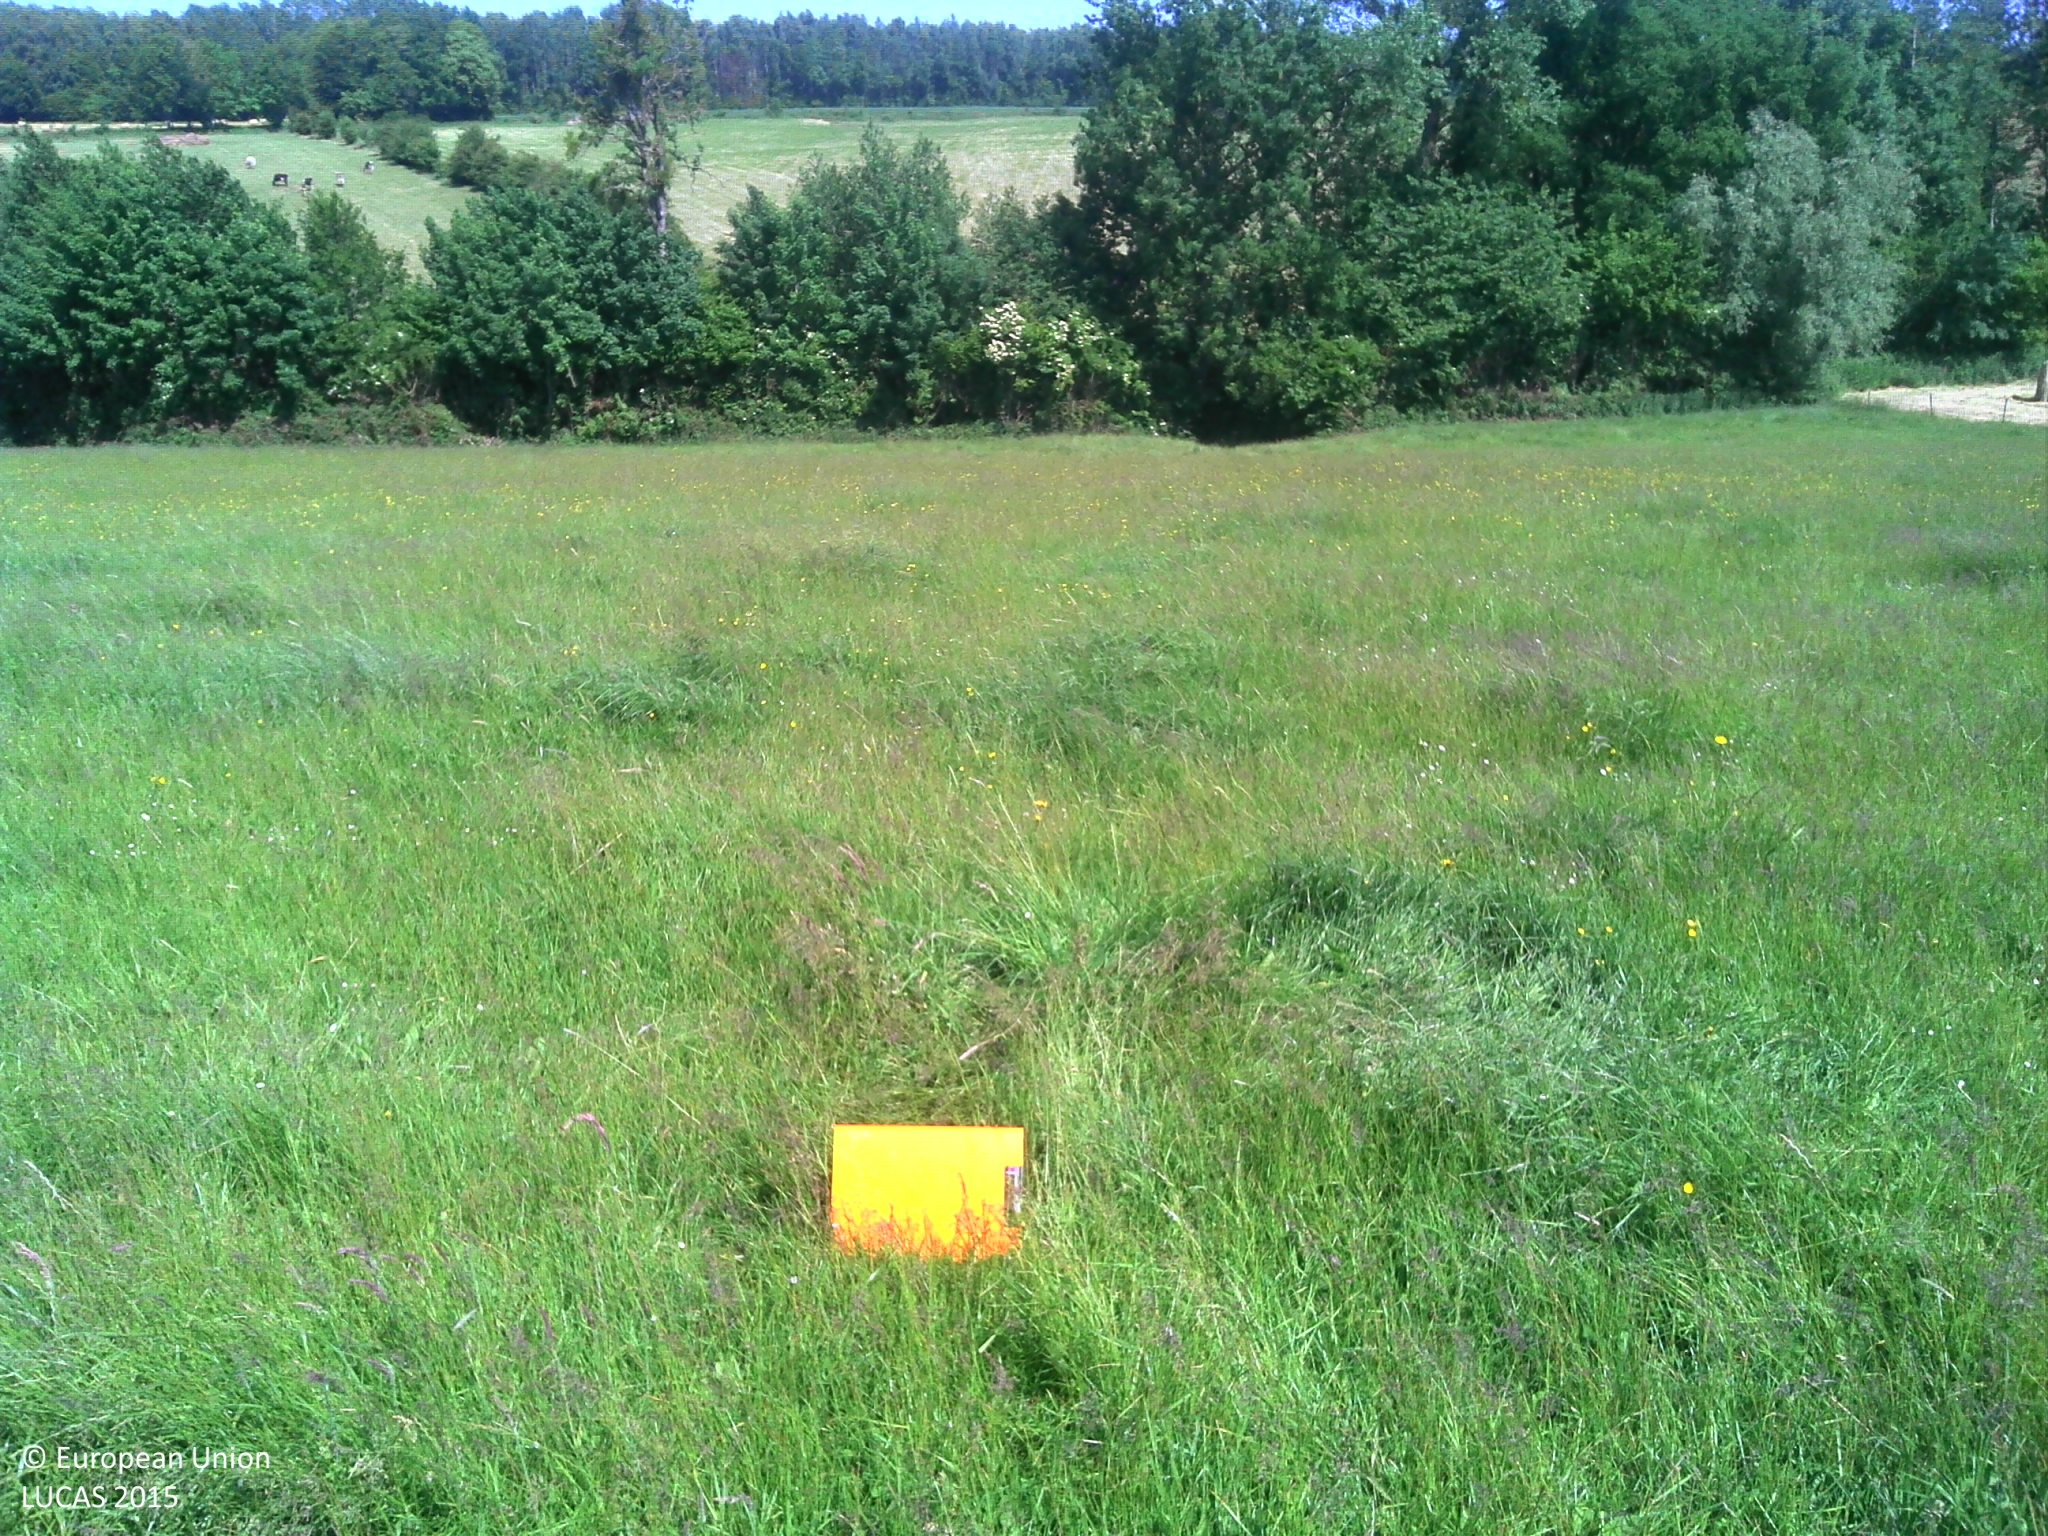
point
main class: Grassland
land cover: Grassland without tree/shrub cover
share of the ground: > 75 %
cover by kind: herbaceous plants 100 %
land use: Agriculture (excluding fallow land and kitchen gardens)
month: June
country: FR
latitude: 49.8310
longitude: 4.0584
